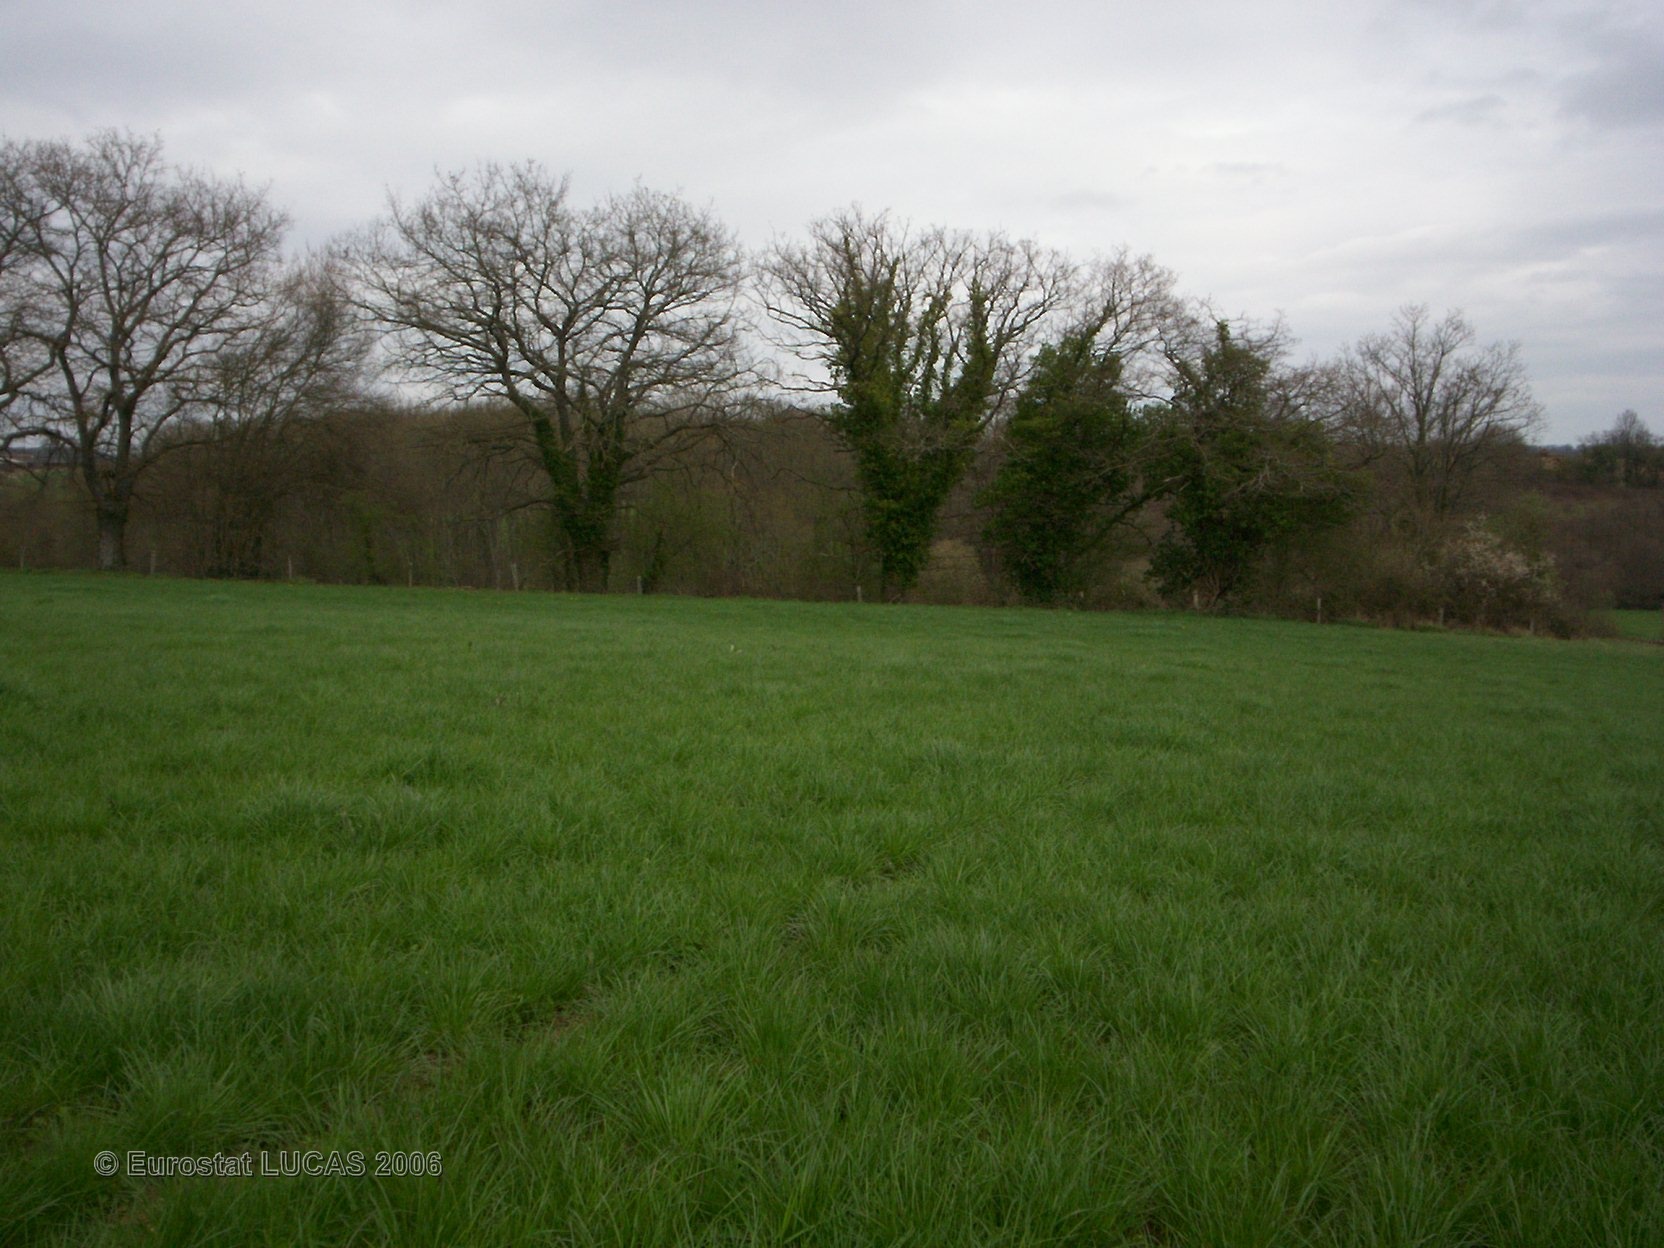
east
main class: Grassland
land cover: Grassland without tree/shrub cover
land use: Agriculture (excluding fallow land and kitchen gardens)
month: April
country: FR
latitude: 46.7197
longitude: 3.0233
